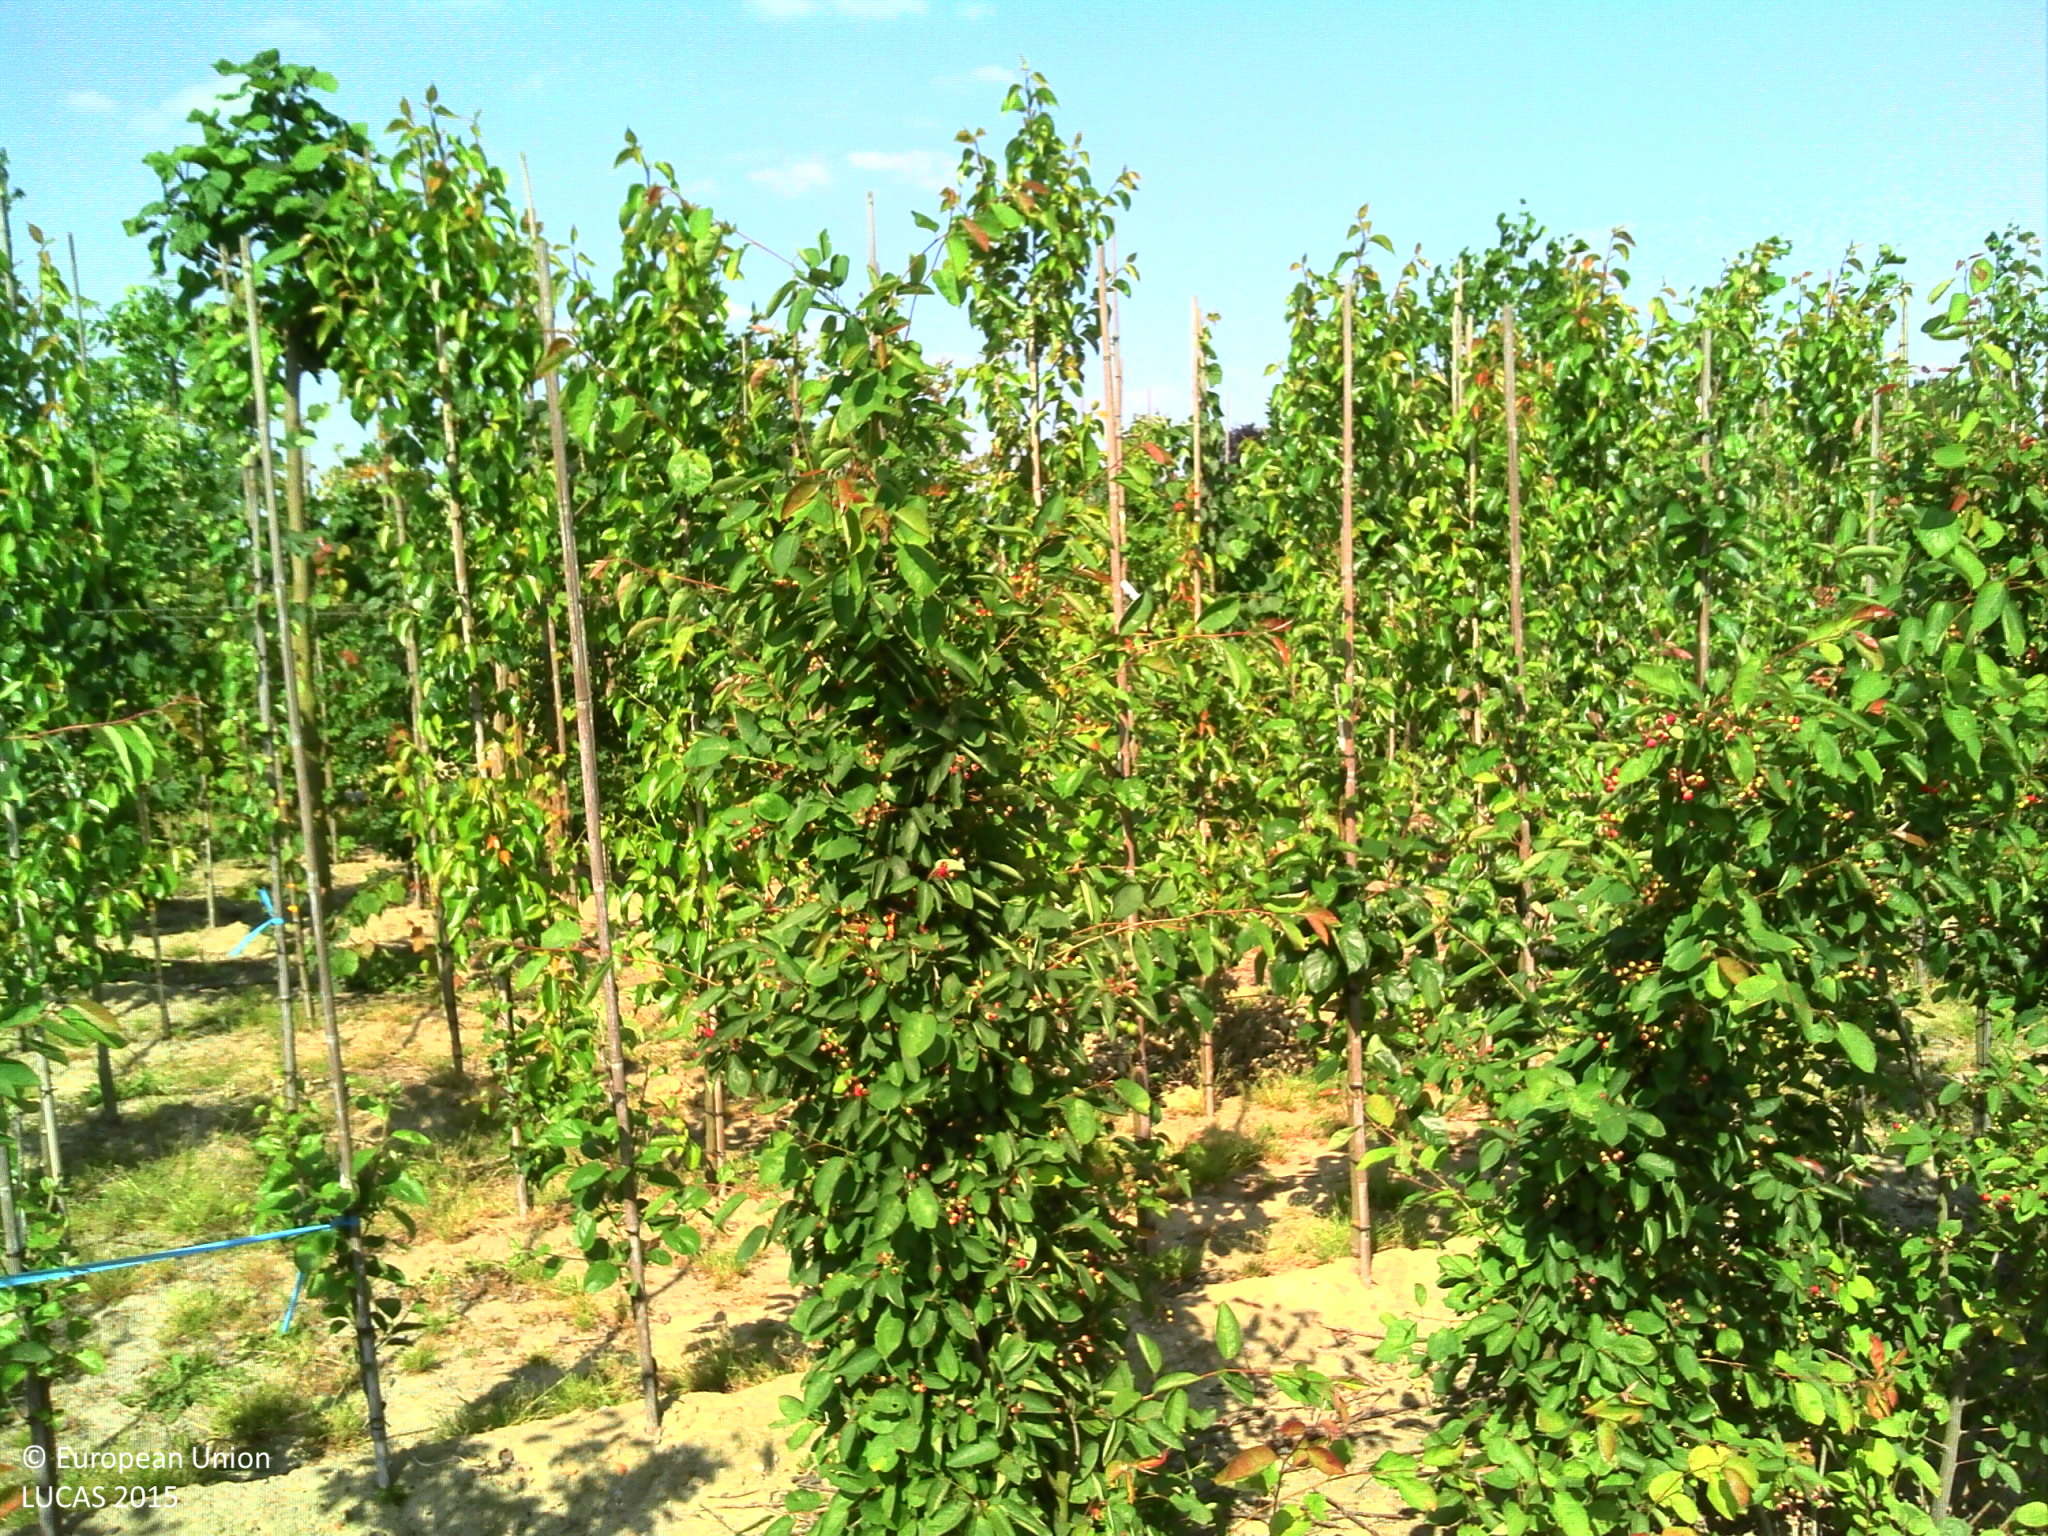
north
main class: Cropland
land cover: Nurseries
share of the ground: < 10 %
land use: Agriculture (excluding fallow land and kitchen gardens)
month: June
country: BE
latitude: 50.9952
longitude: 3.9098
